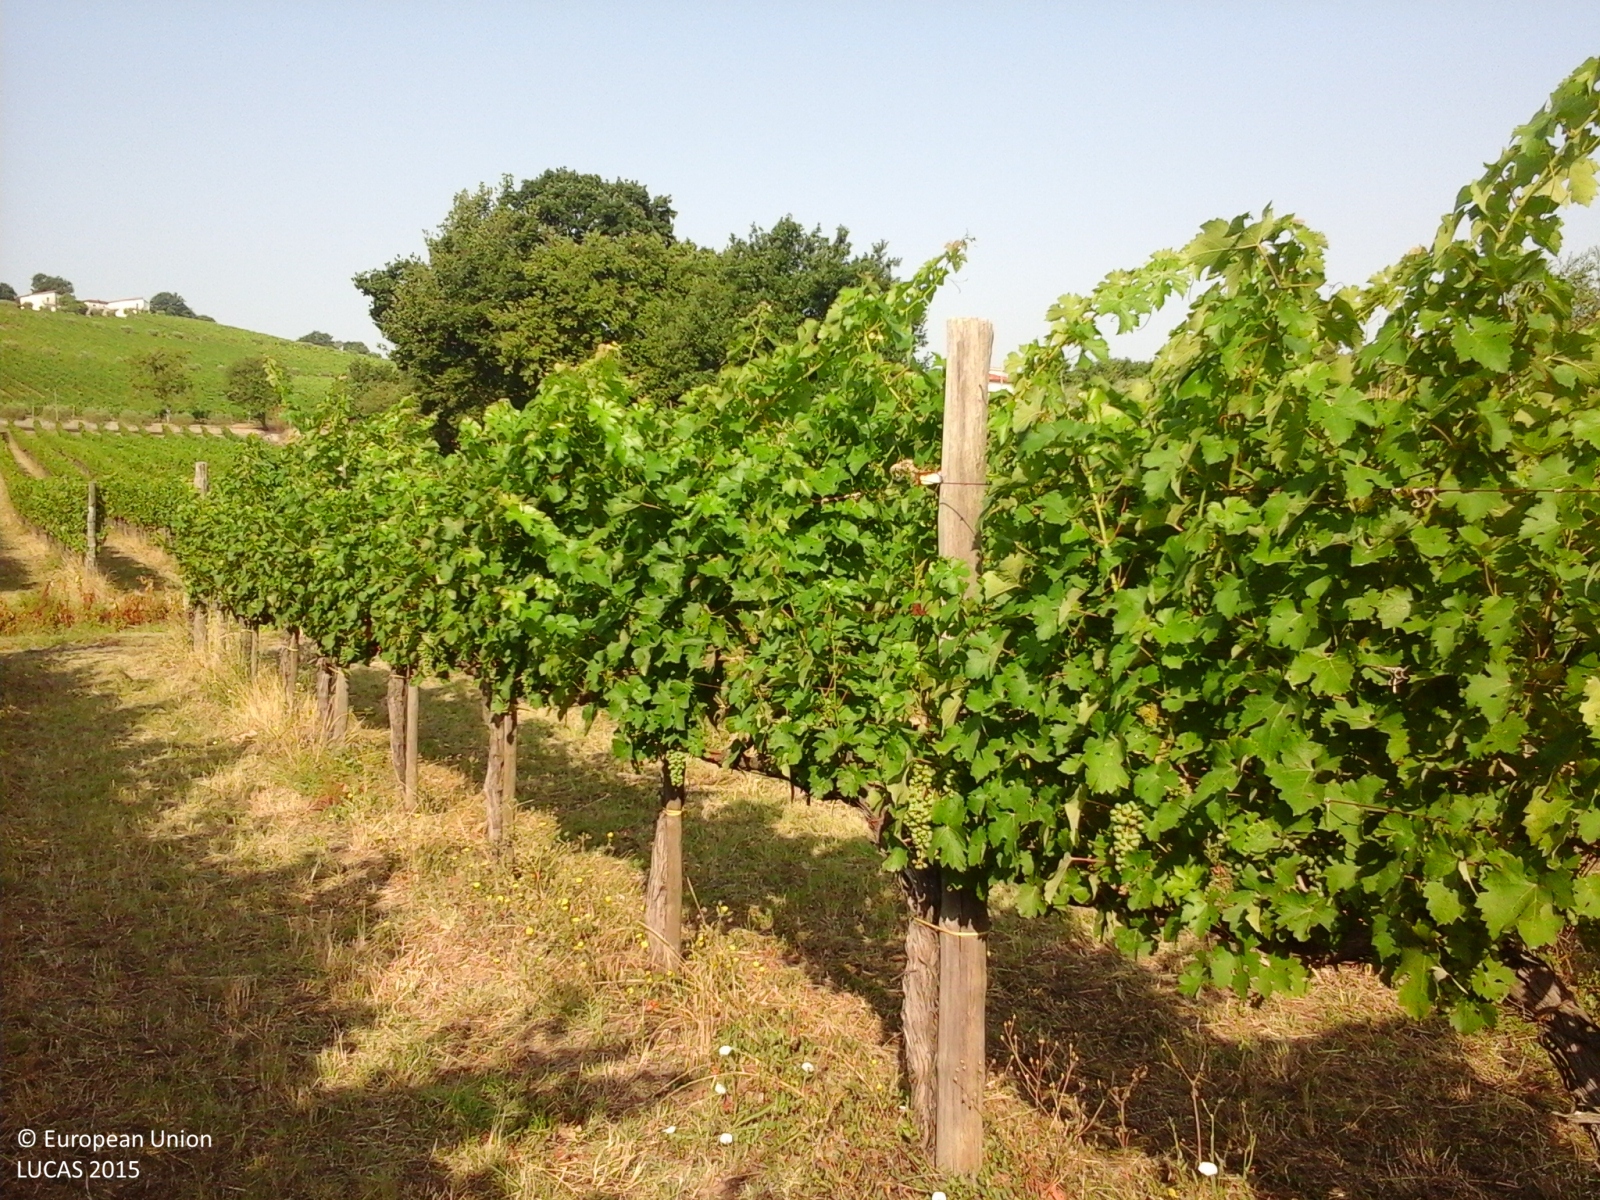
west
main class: Cropland
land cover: Vineyards
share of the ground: > 75 %
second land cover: Spontaneously vegetated surfaces
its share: > 75 %
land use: Agriculture (excluding fallow land and kitchen gardens)
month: July
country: IT
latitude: 40.9924
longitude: 14.9853
